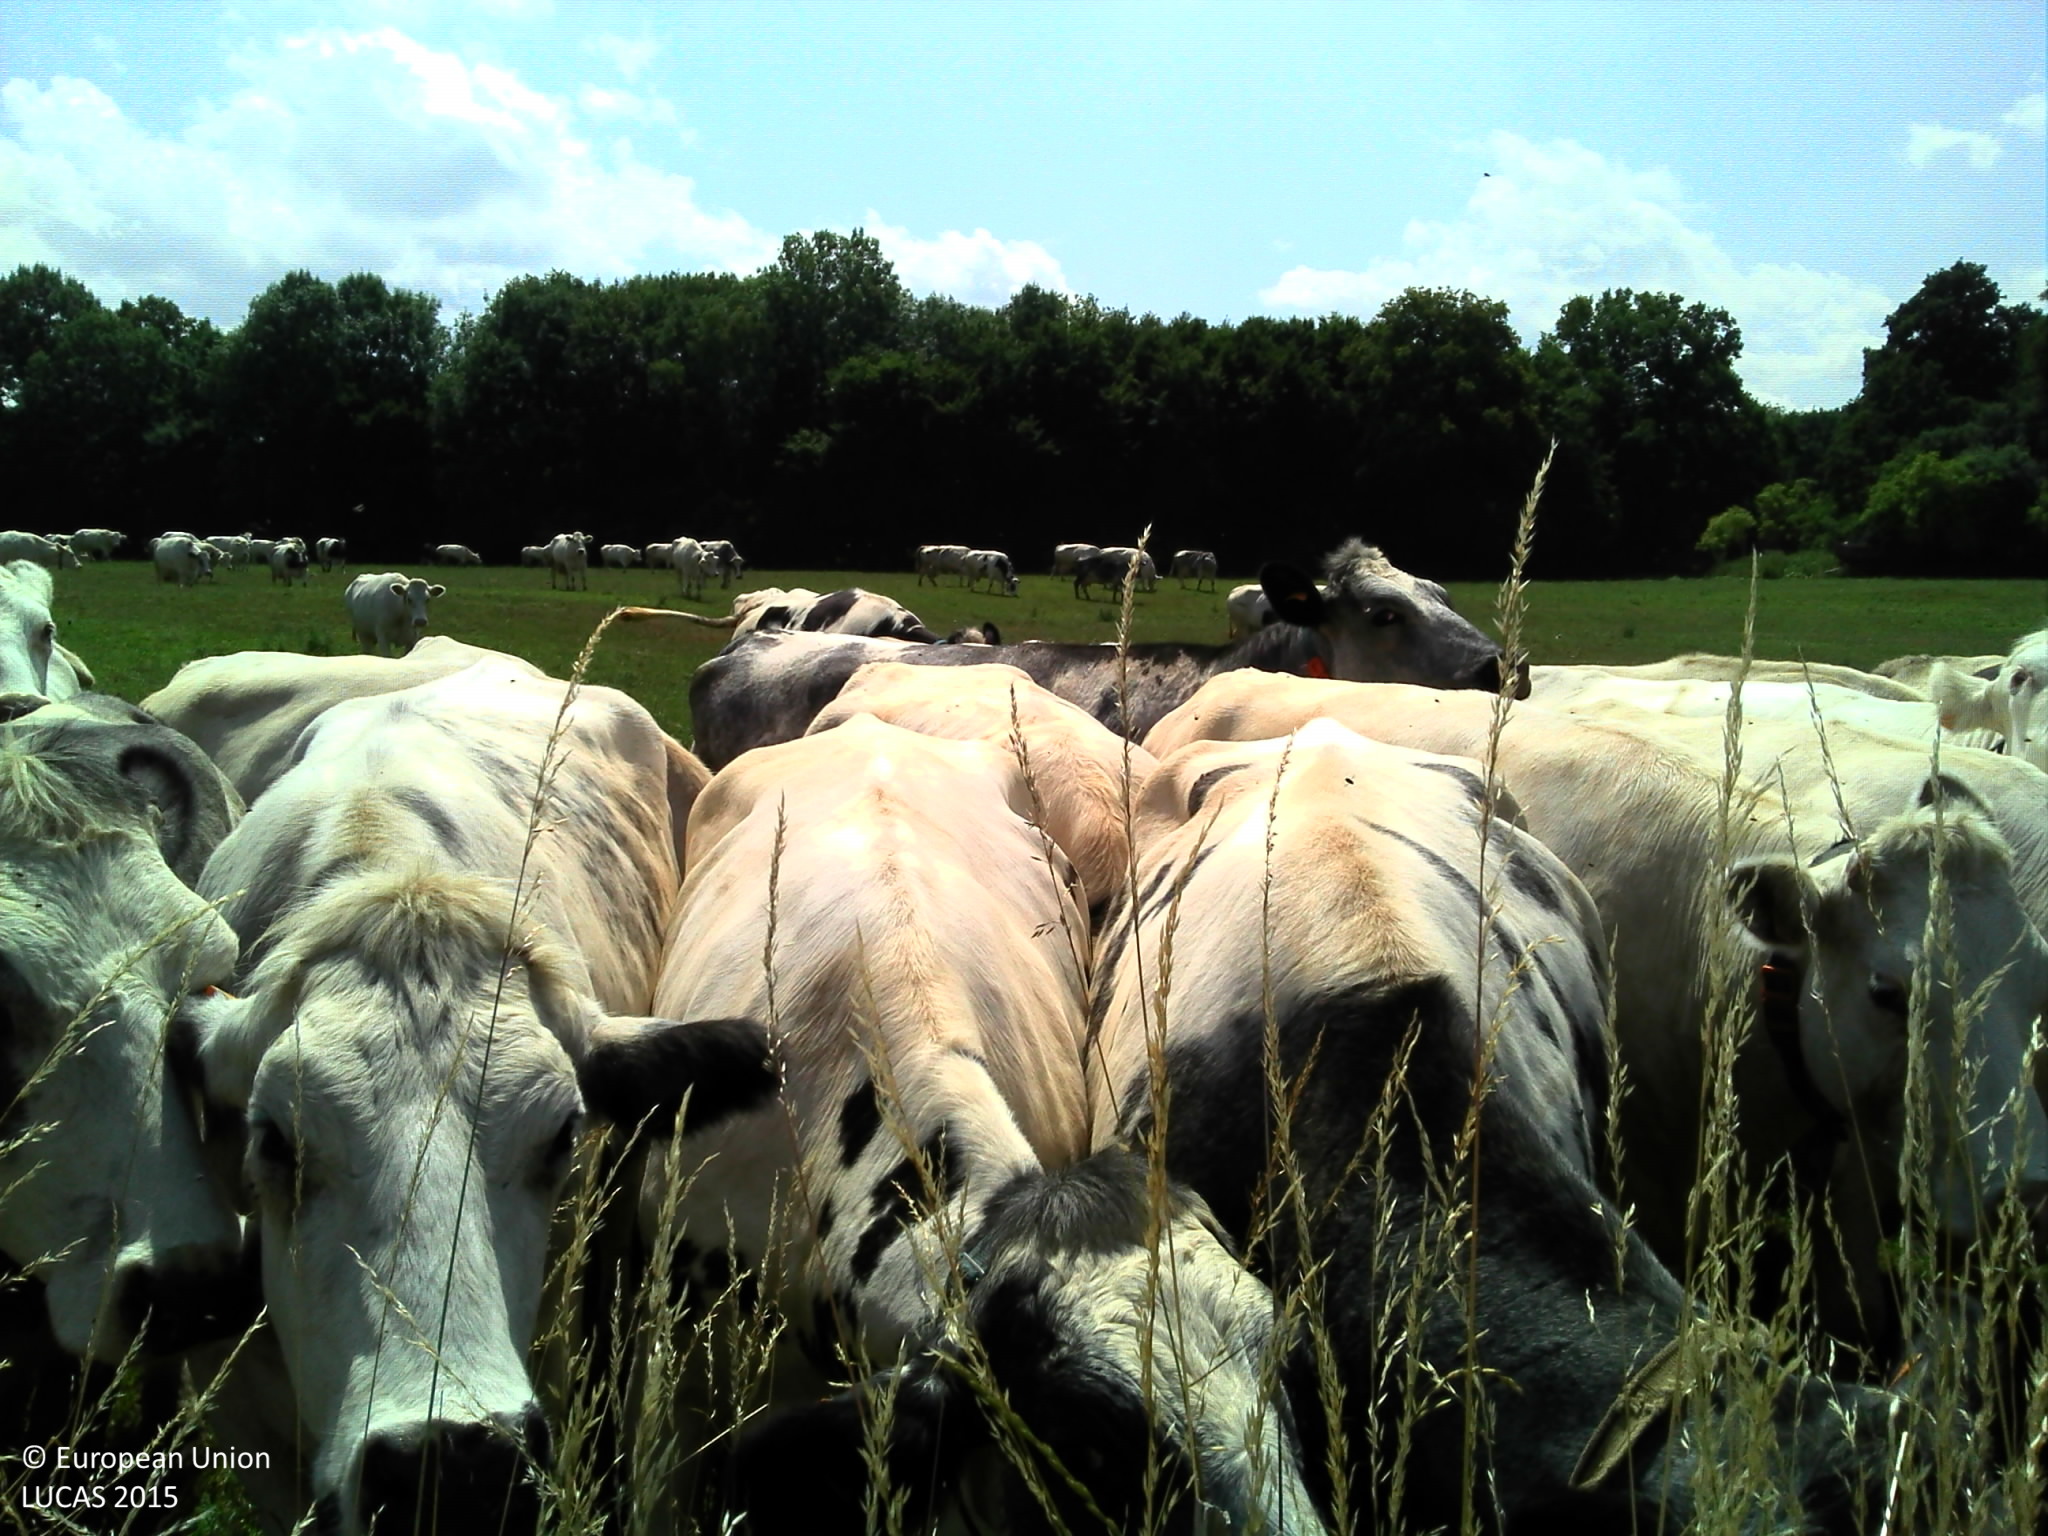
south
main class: Grassland
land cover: Grassland without tree/shrub cover
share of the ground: > 75 %
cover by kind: herbaceous plants 100 %
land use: Agriculture (excluding fallow land and kitchen gardens)
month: July
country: BE
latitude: 50.2889
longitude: 4.1982
